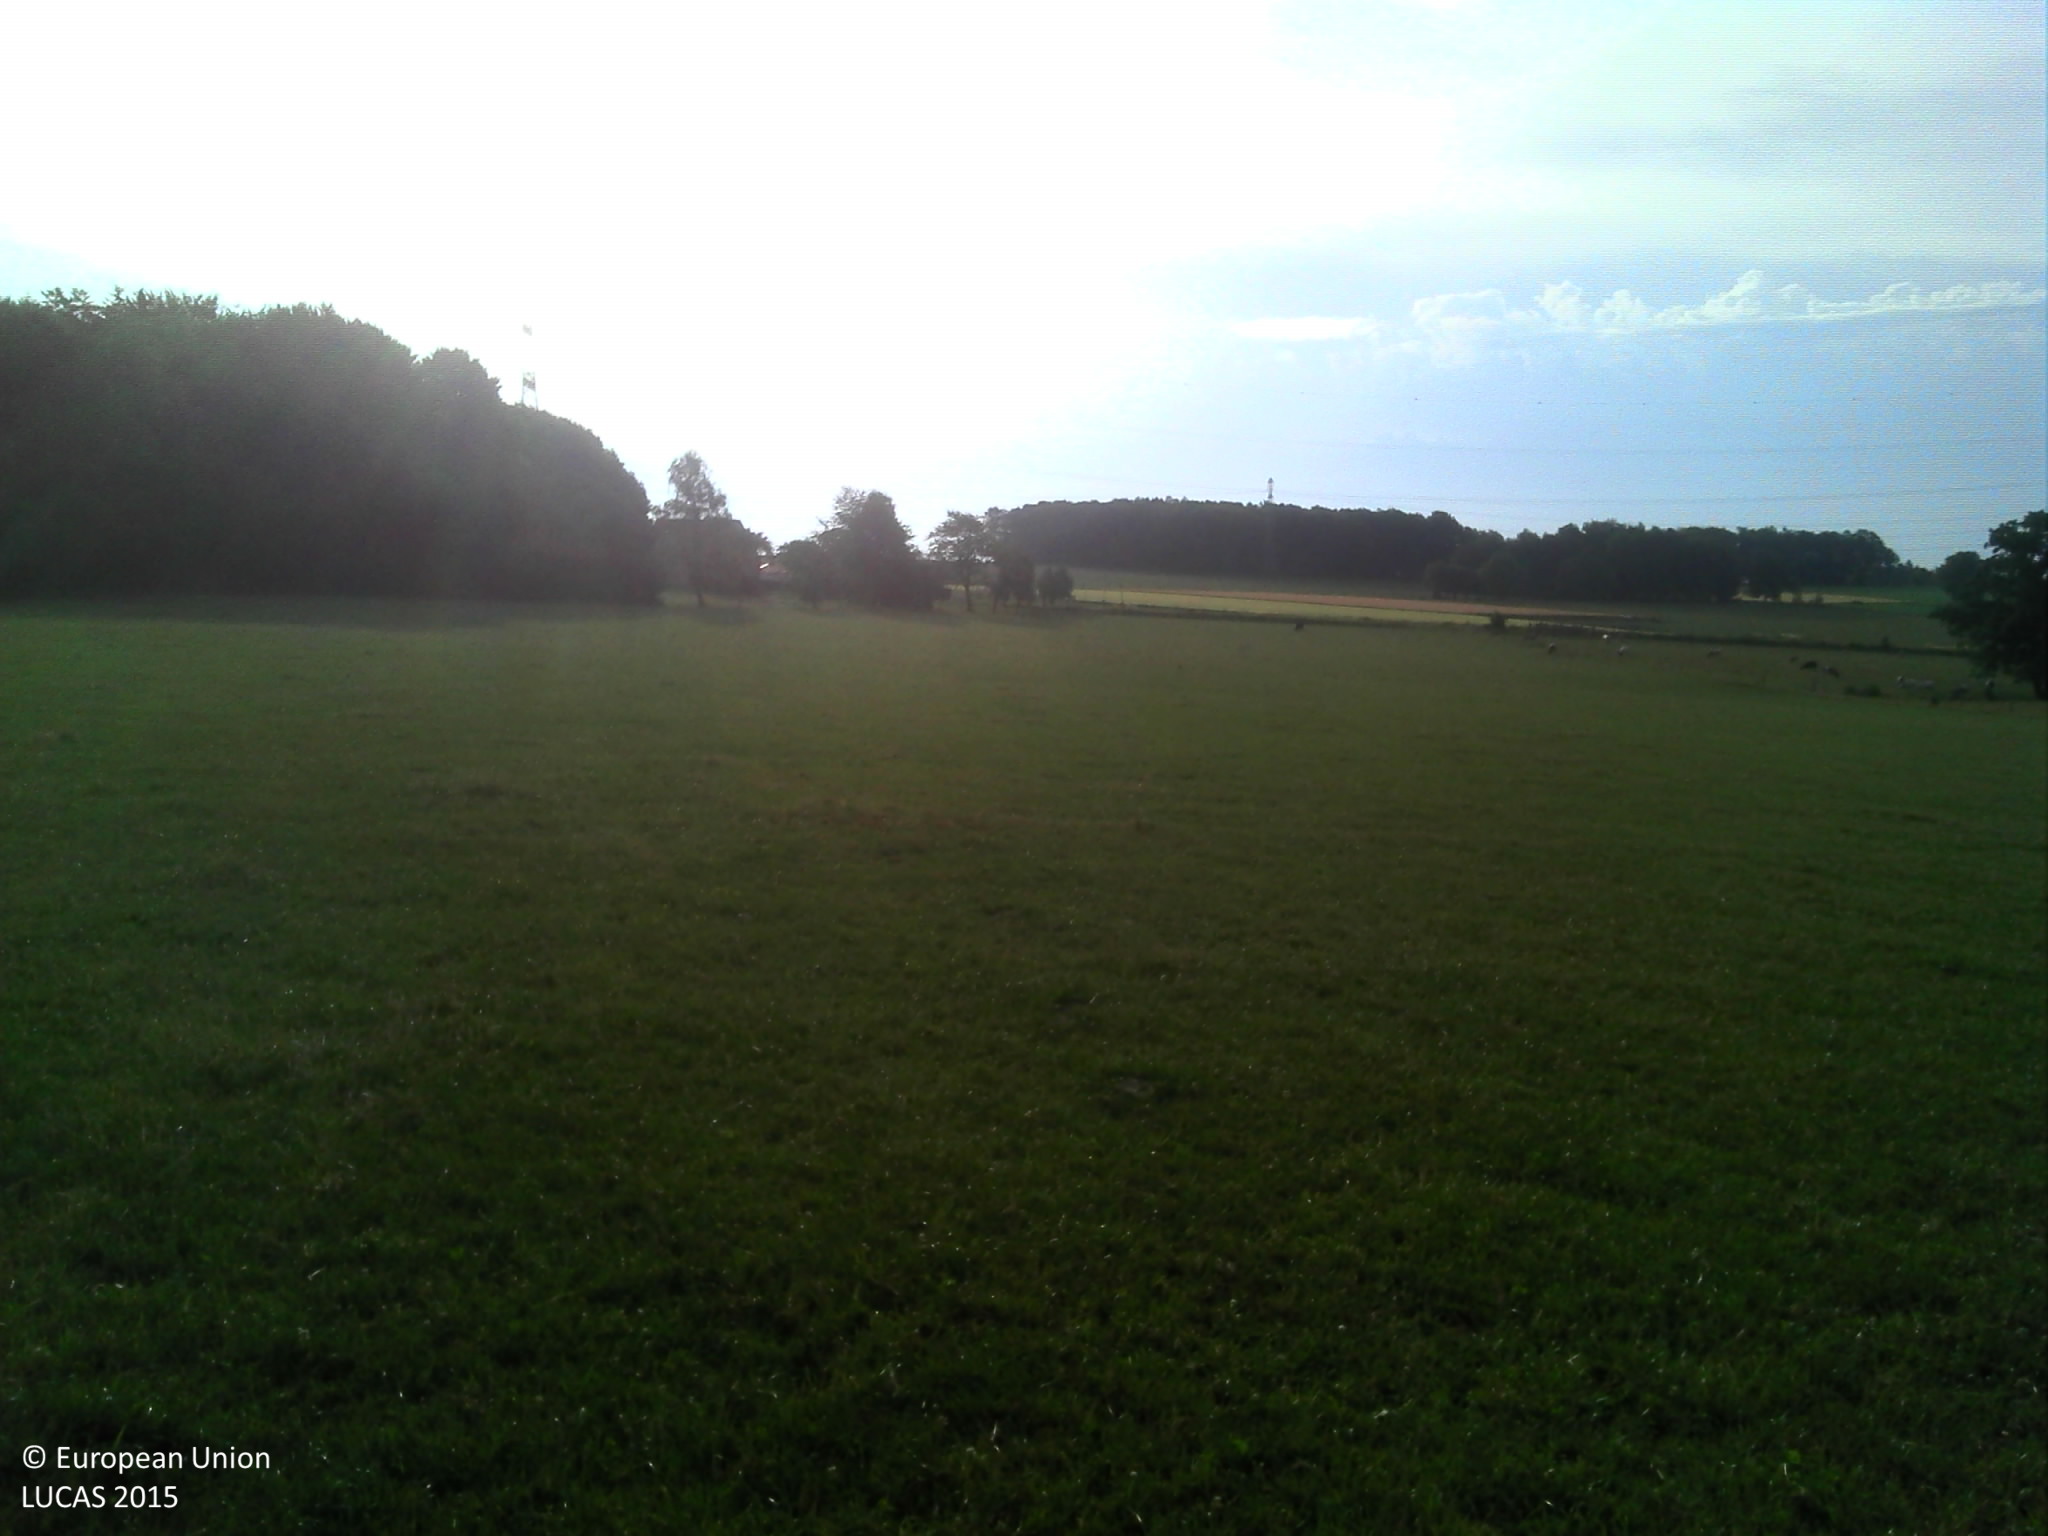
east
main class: Grassland
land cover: Grassland without tree/shrub cover
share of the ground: > 75 %
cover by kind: herbaceous plants 100 %
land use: Agriculture (excluding fallow land and kitchen gardens)
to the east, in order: Grassland without tree/shrub cover
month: July
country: BE
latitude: 49.9398
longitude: 5.6653
